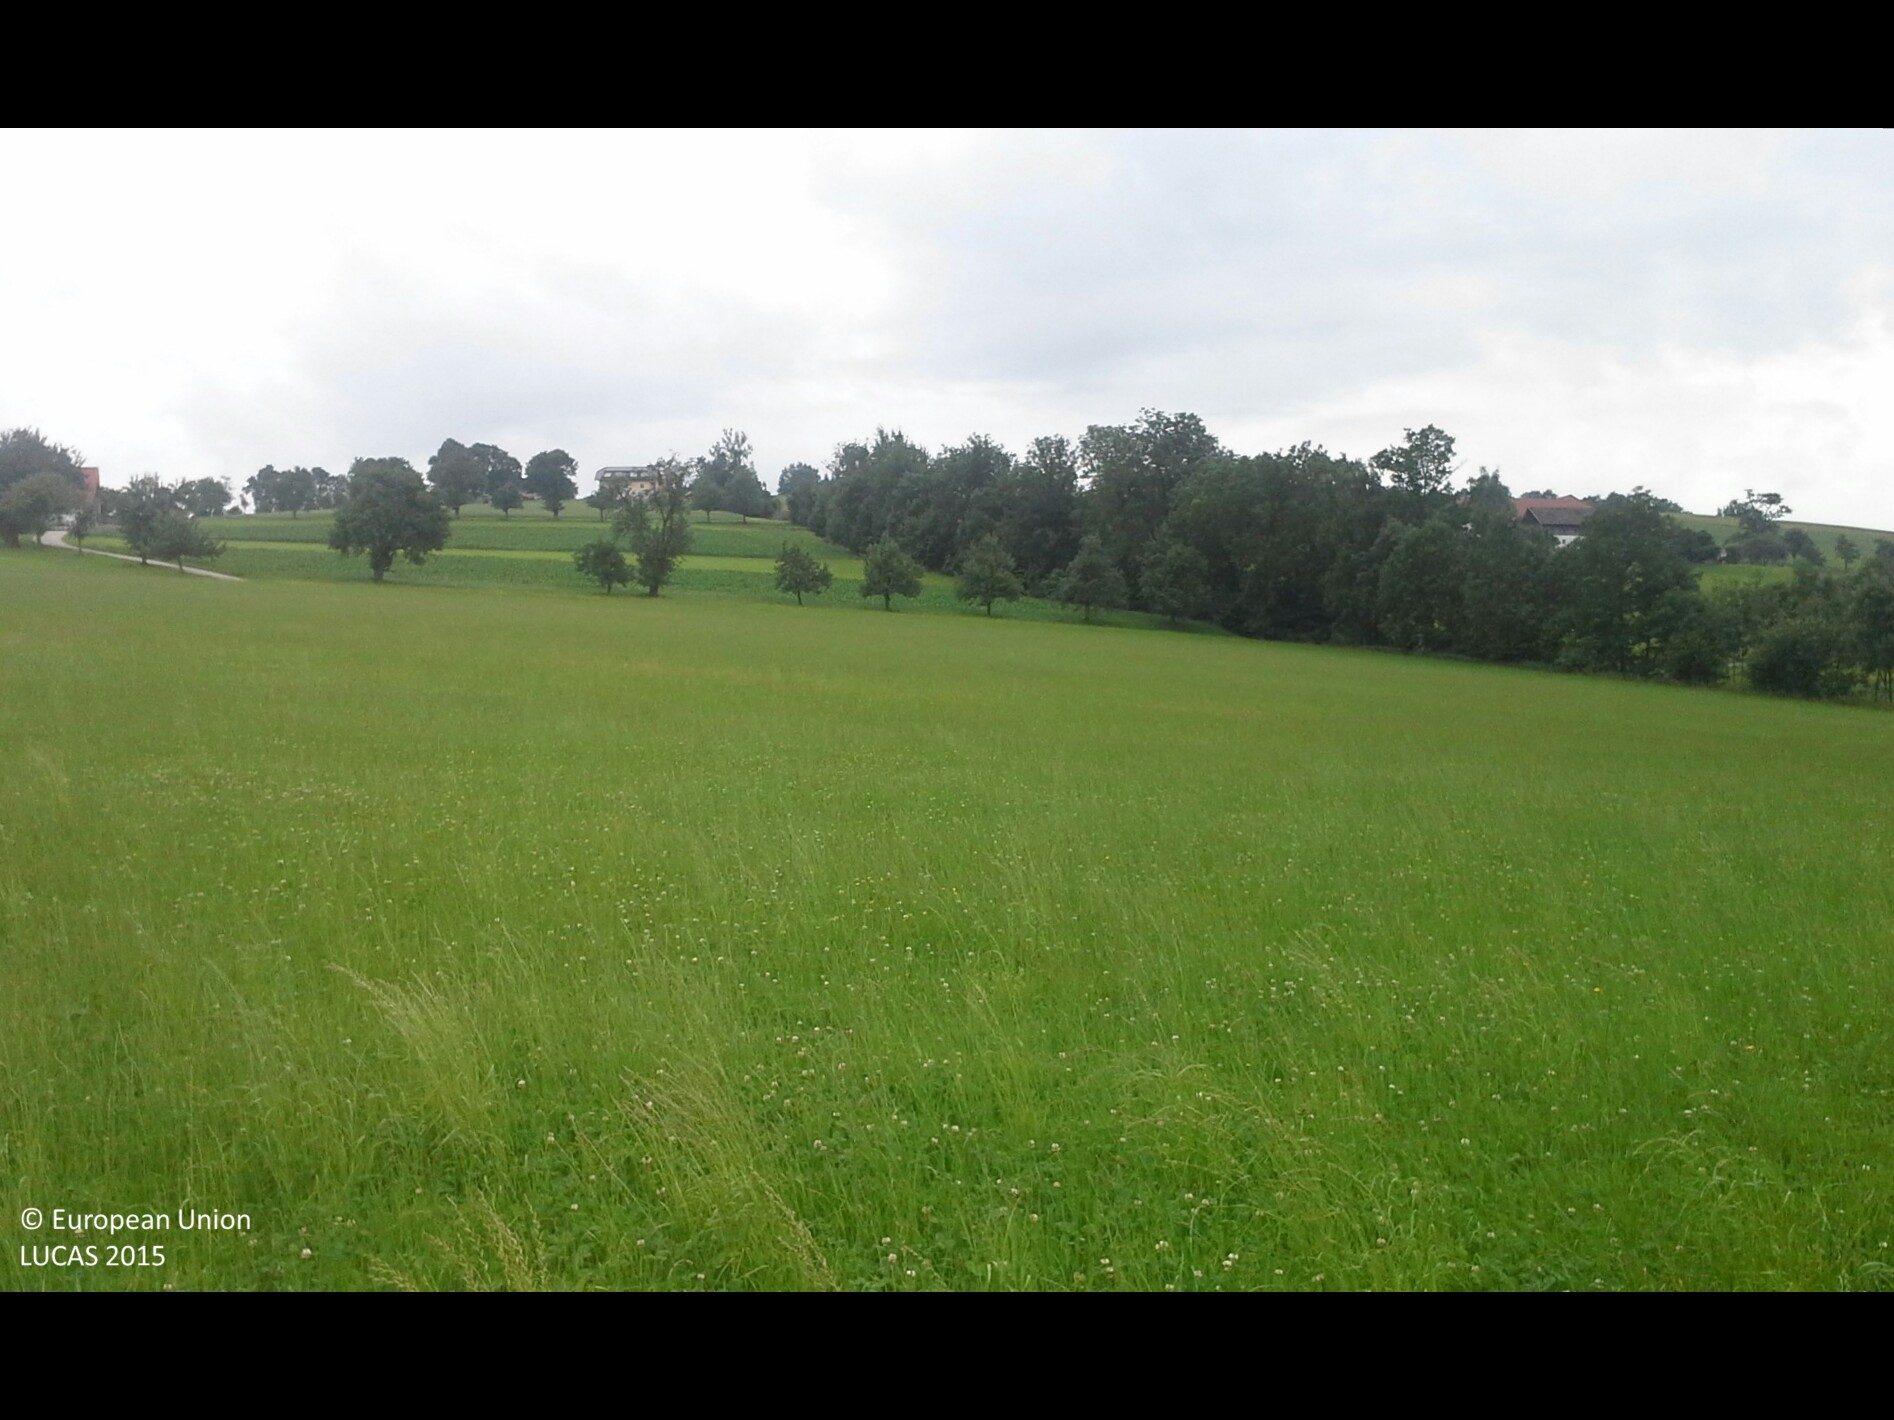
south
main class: Grassland
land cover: Grassland without tree/shrub cover
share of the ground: > 75 %
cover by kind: herbaceous plants 100 %
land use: Agriculture (excluding fallow land and kitchen gardens)
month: June
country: AT
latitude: 47.9944
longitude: 14.3283
